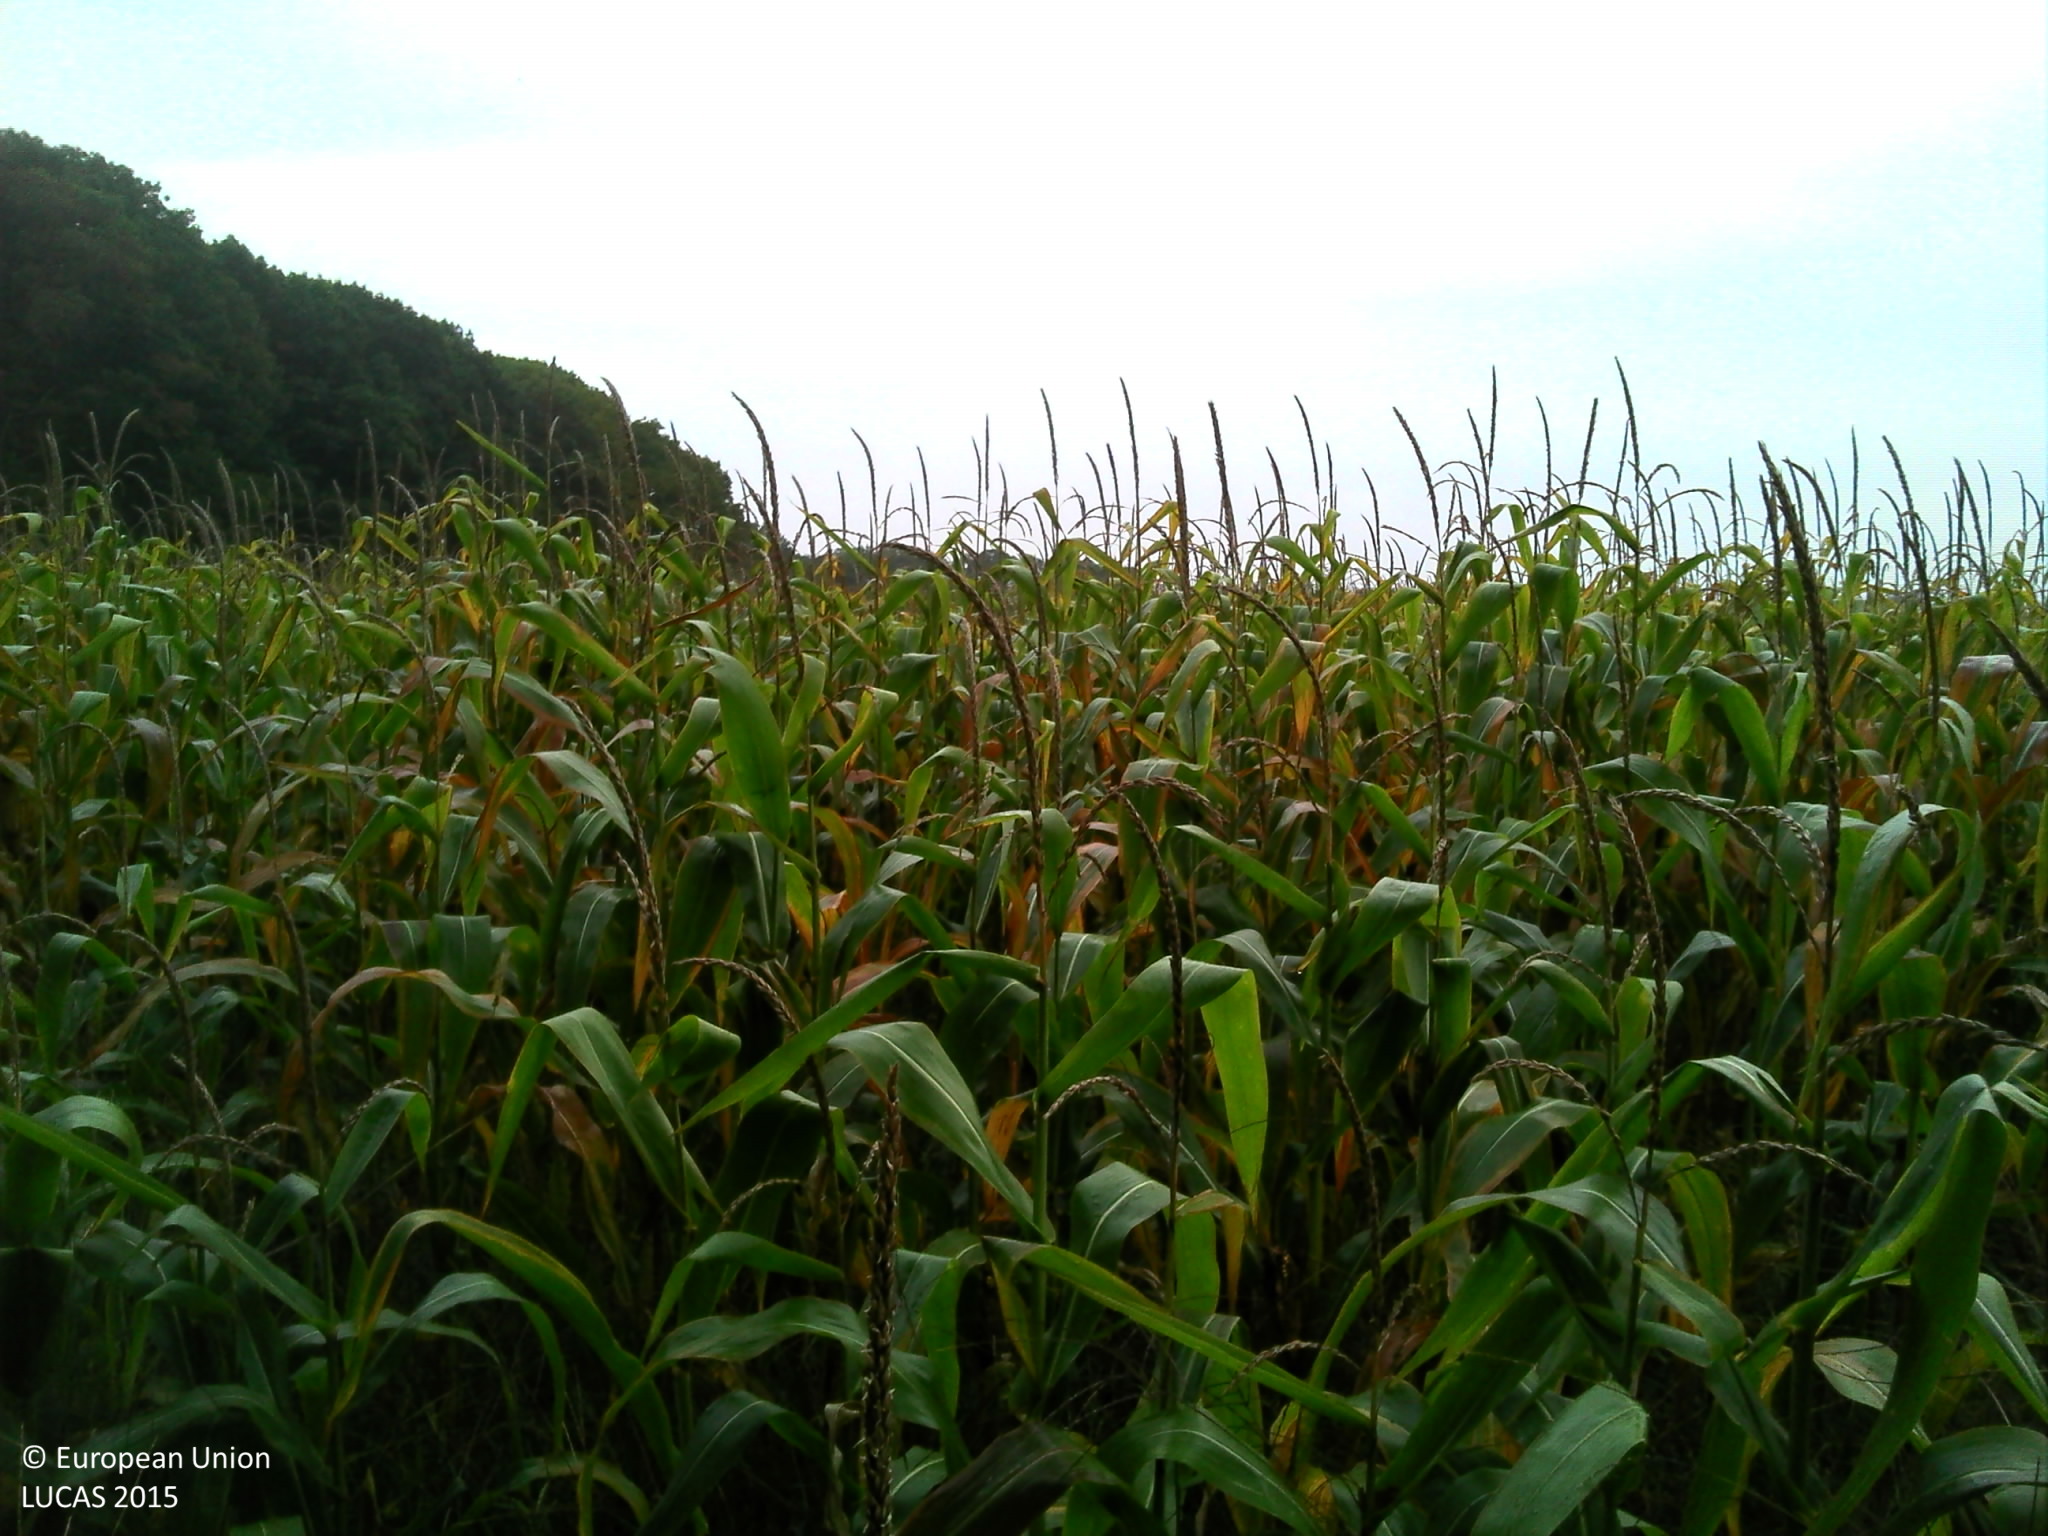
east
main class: Cropland
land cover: Maize
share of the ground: > 75 %
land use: Agriculture (excluding fallow land and kitchen gardens)
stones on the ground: < 10 %
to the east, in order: Maize; Grass margins; Inland fresh running water; Grass margins; Maize
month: October
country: BE
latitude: 51.1086
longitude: 4.7545
